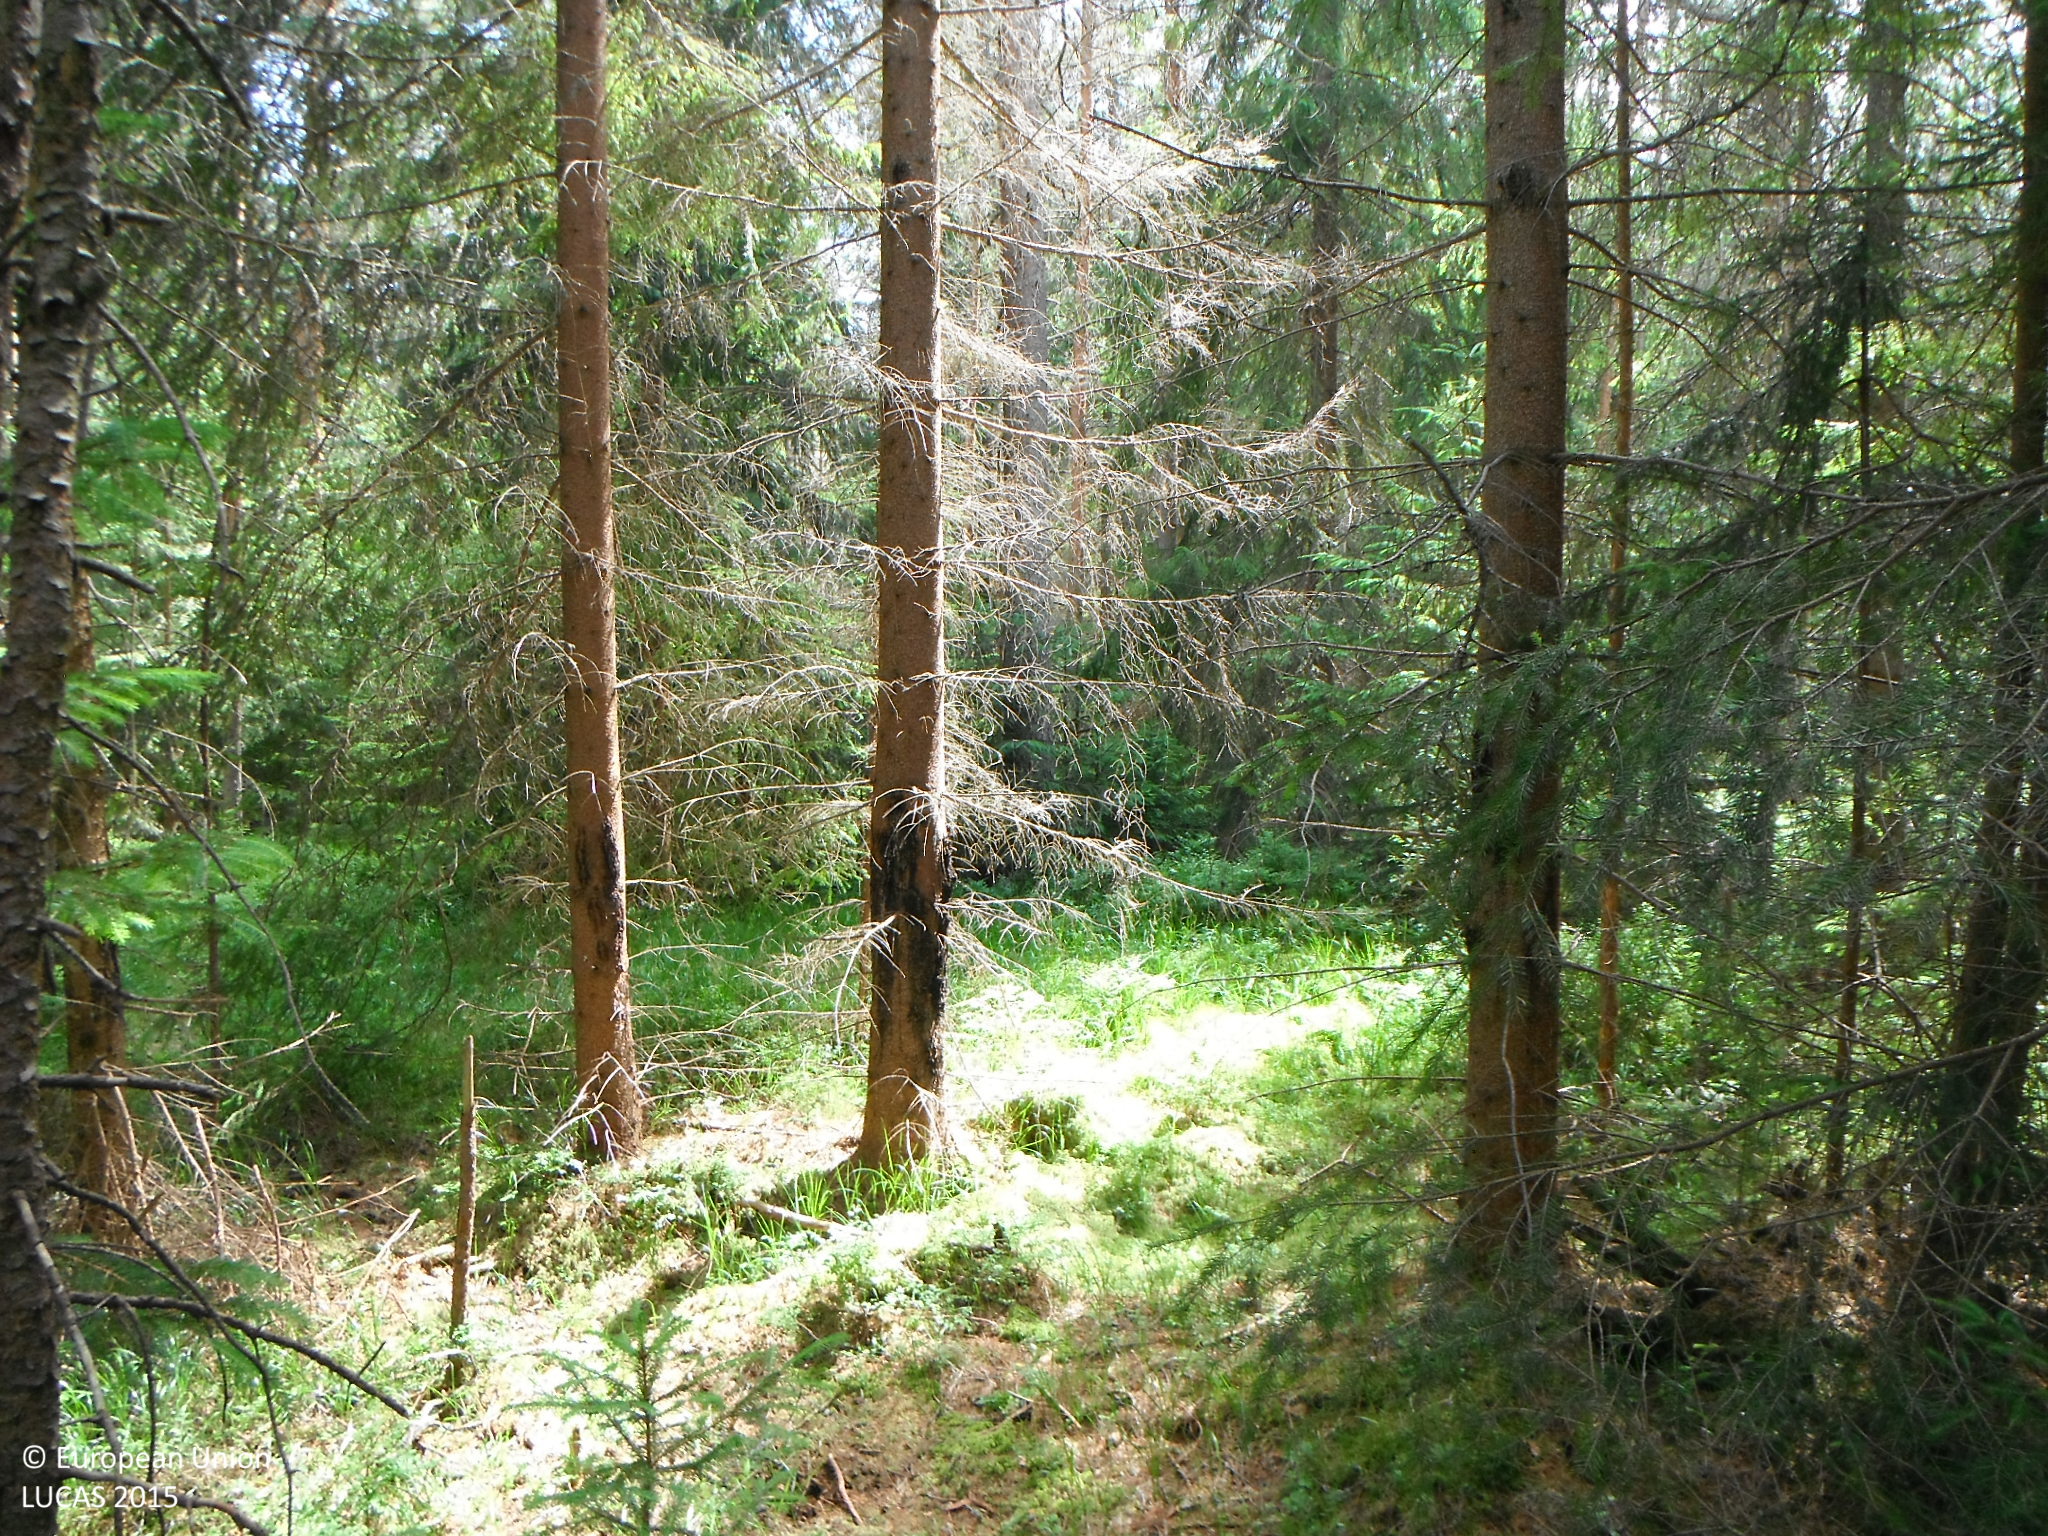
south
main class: Woodland
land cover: Spruce dominated coniferous woodland
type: alpine coniferous forest
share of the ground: > 75 %
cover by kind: coniferous forest trees 100 %
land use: Forestry
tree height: > 5 m
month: July
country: SK
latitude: 49.4012
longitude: 19.7717
